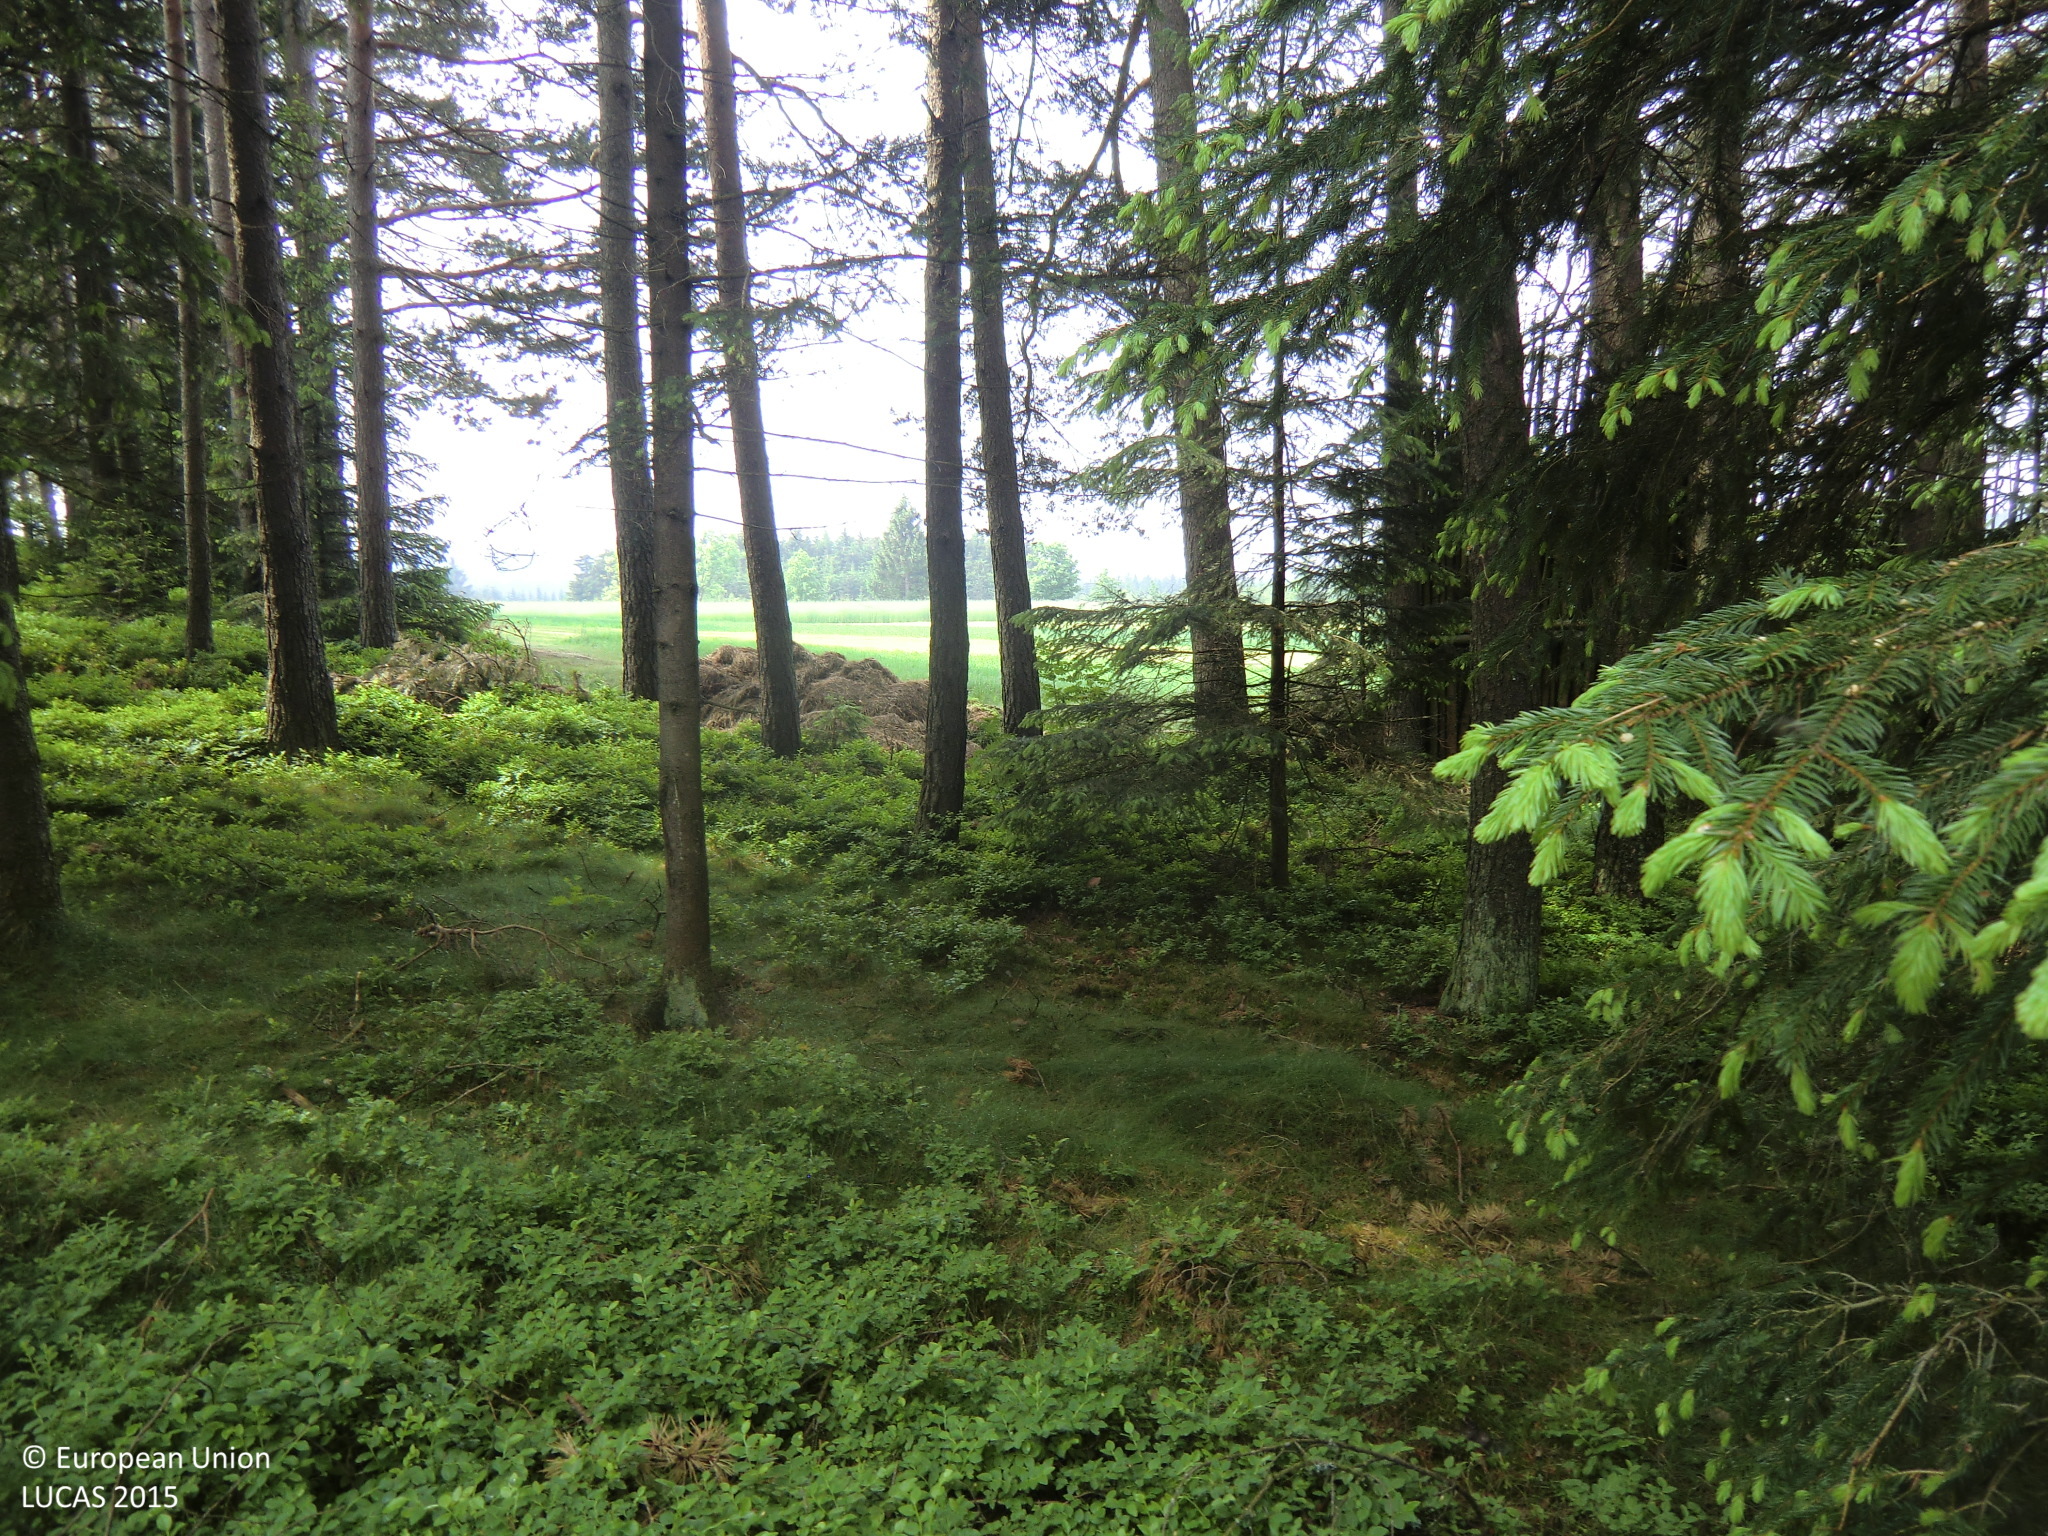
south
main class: Woodland
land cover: Pine dominated coniferous woodland
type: hemiboreal forest and nemoral coniferous forest and mixed broadleaved-coniferous forest
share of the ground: > 75 %
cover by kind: coniferous forest trees 80 %, shrubs 20 %
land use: Forestry
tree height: > 5 m
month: June
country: AT
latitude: 48.6062
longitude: 14.7887
